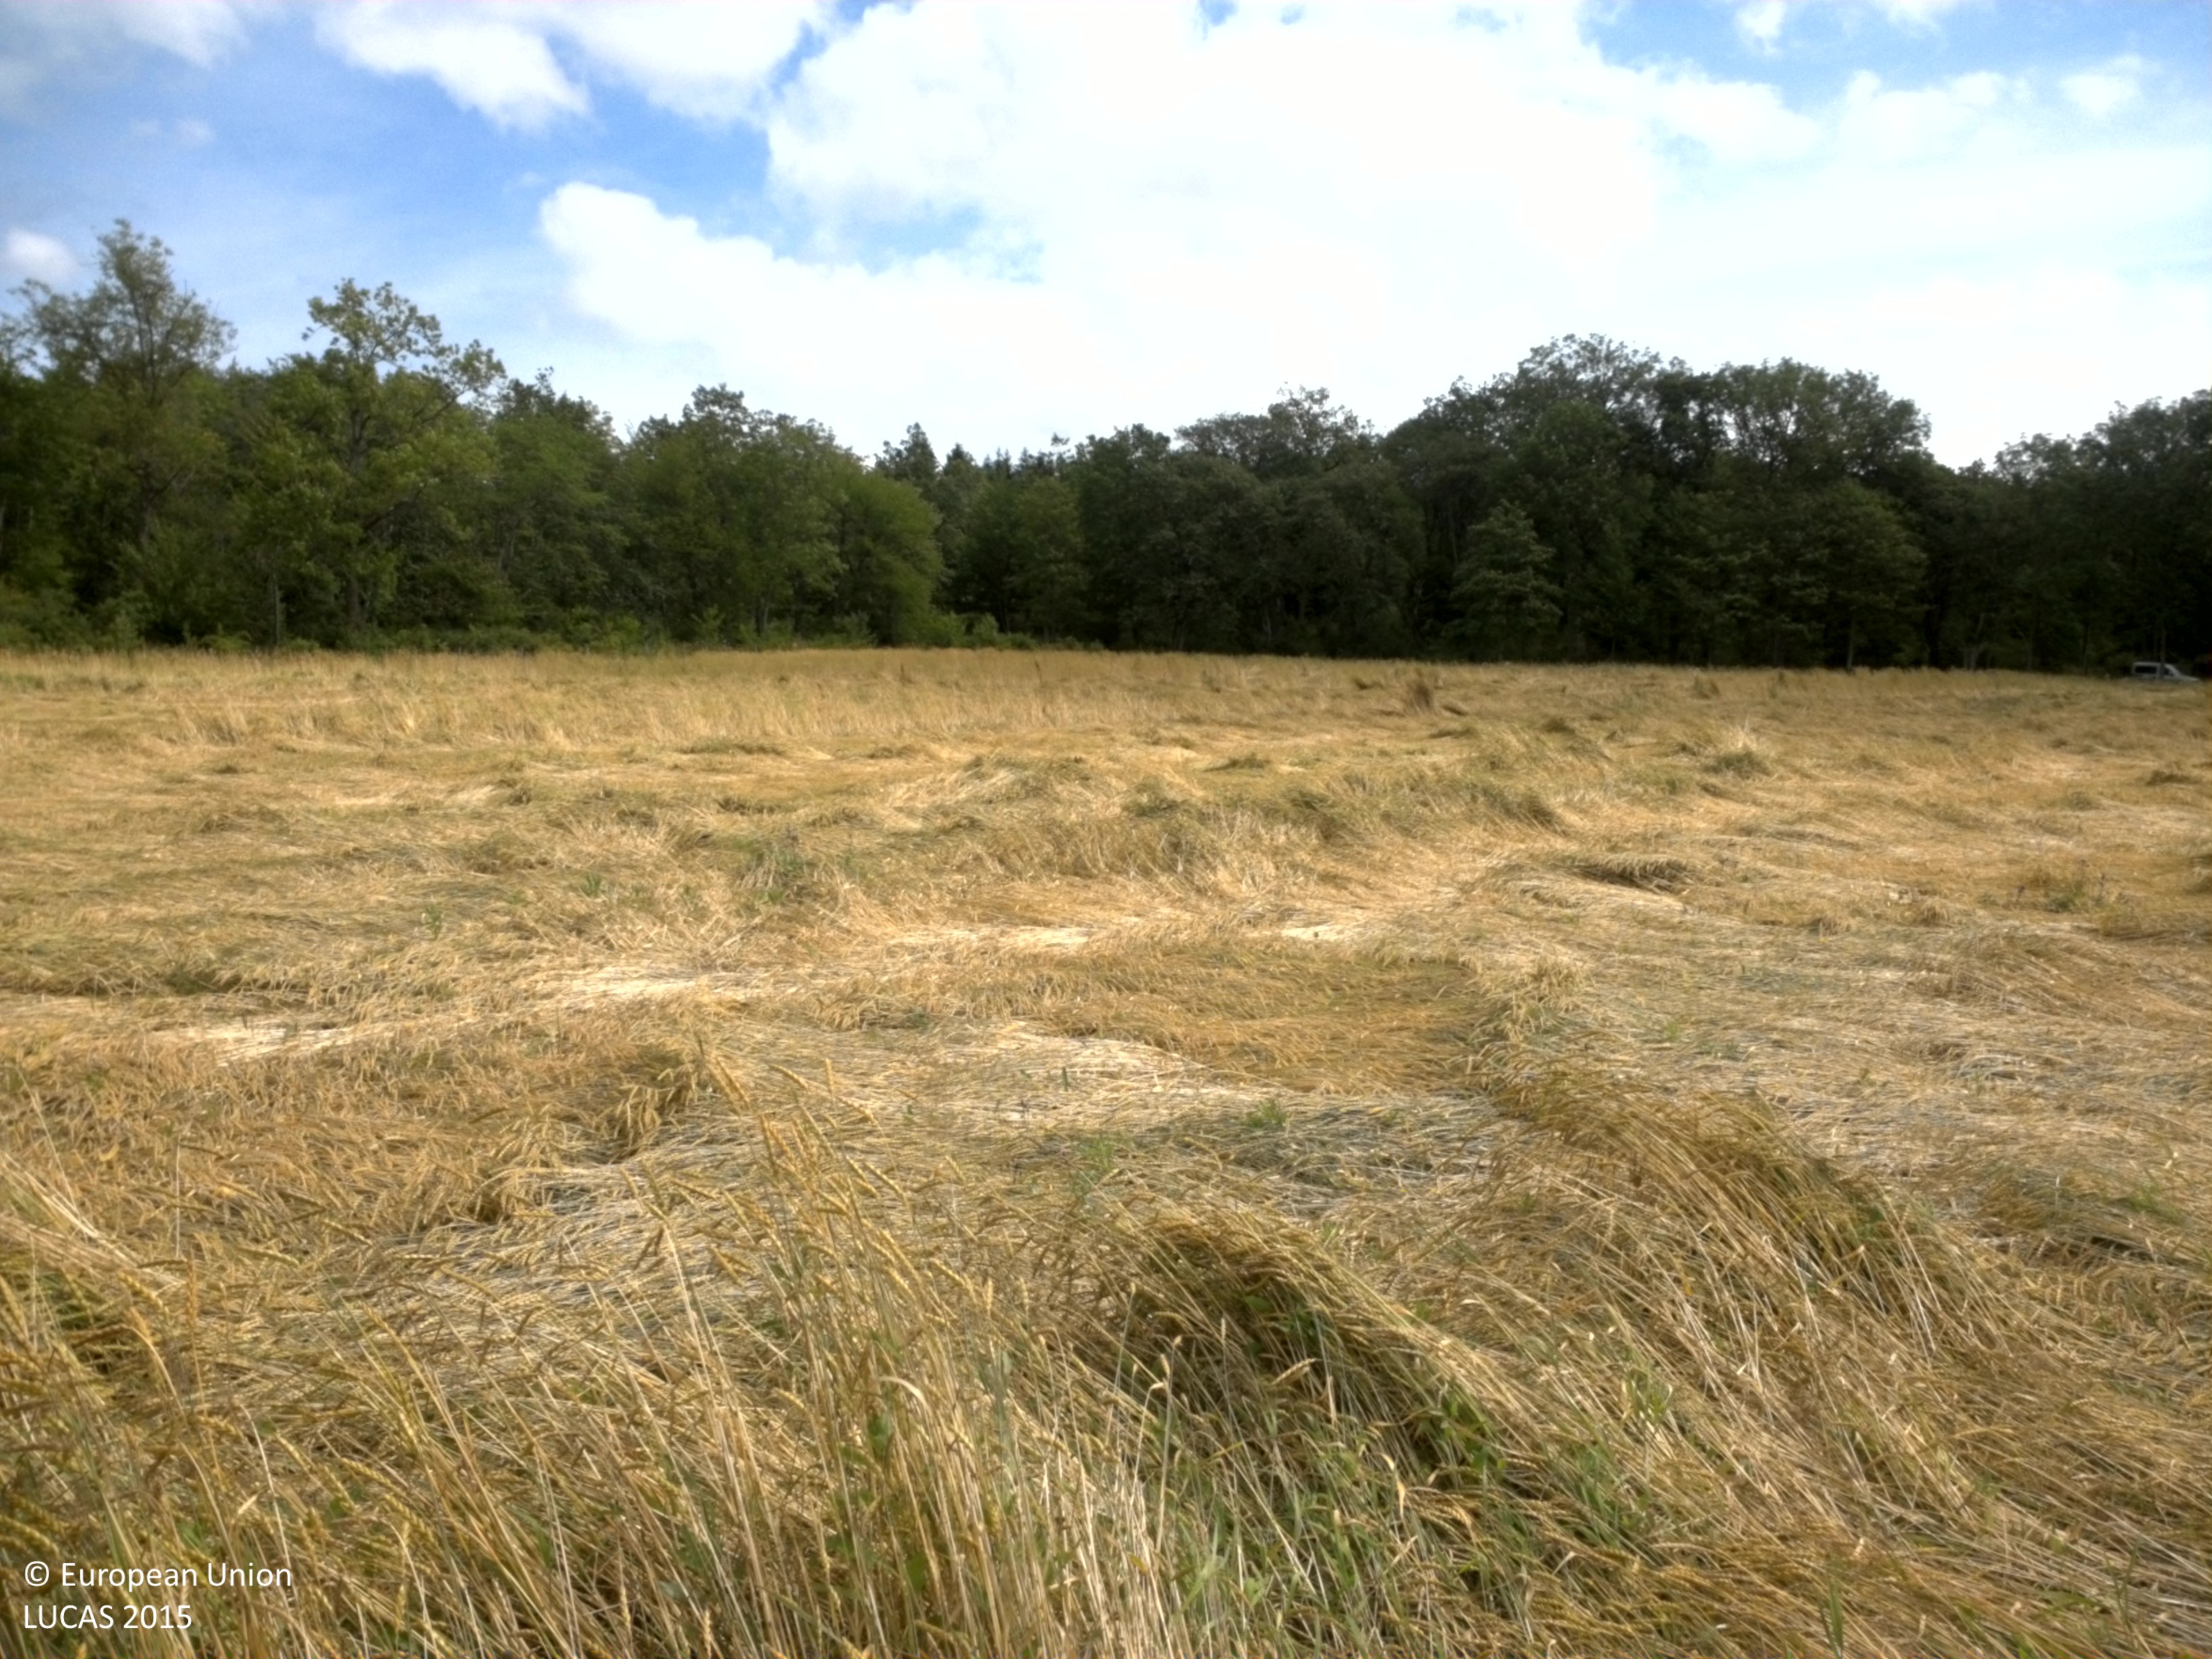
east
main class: Cropland
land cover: Common wheat
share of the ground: > 75 %
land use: Agriculture (excluding fallow land and kitchen gardens)
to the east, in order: Common wheat; Grass margins; Paved roads, cycling and walking lanes; Grass margins; Fences; Broadleaved woodland; Dry stone walls; Broadleaved woodland; Dry stone walls; Broadleaved woodland; Electric lines; Broadleaved woodland; Shrubland with sparse tree cover; Fences; Grass margins; Electric lines; Spruce dominated mixed woodland; Spruce dominated coniferous woodland
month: July
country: SE
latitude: 58.5380
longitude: 13.3436
